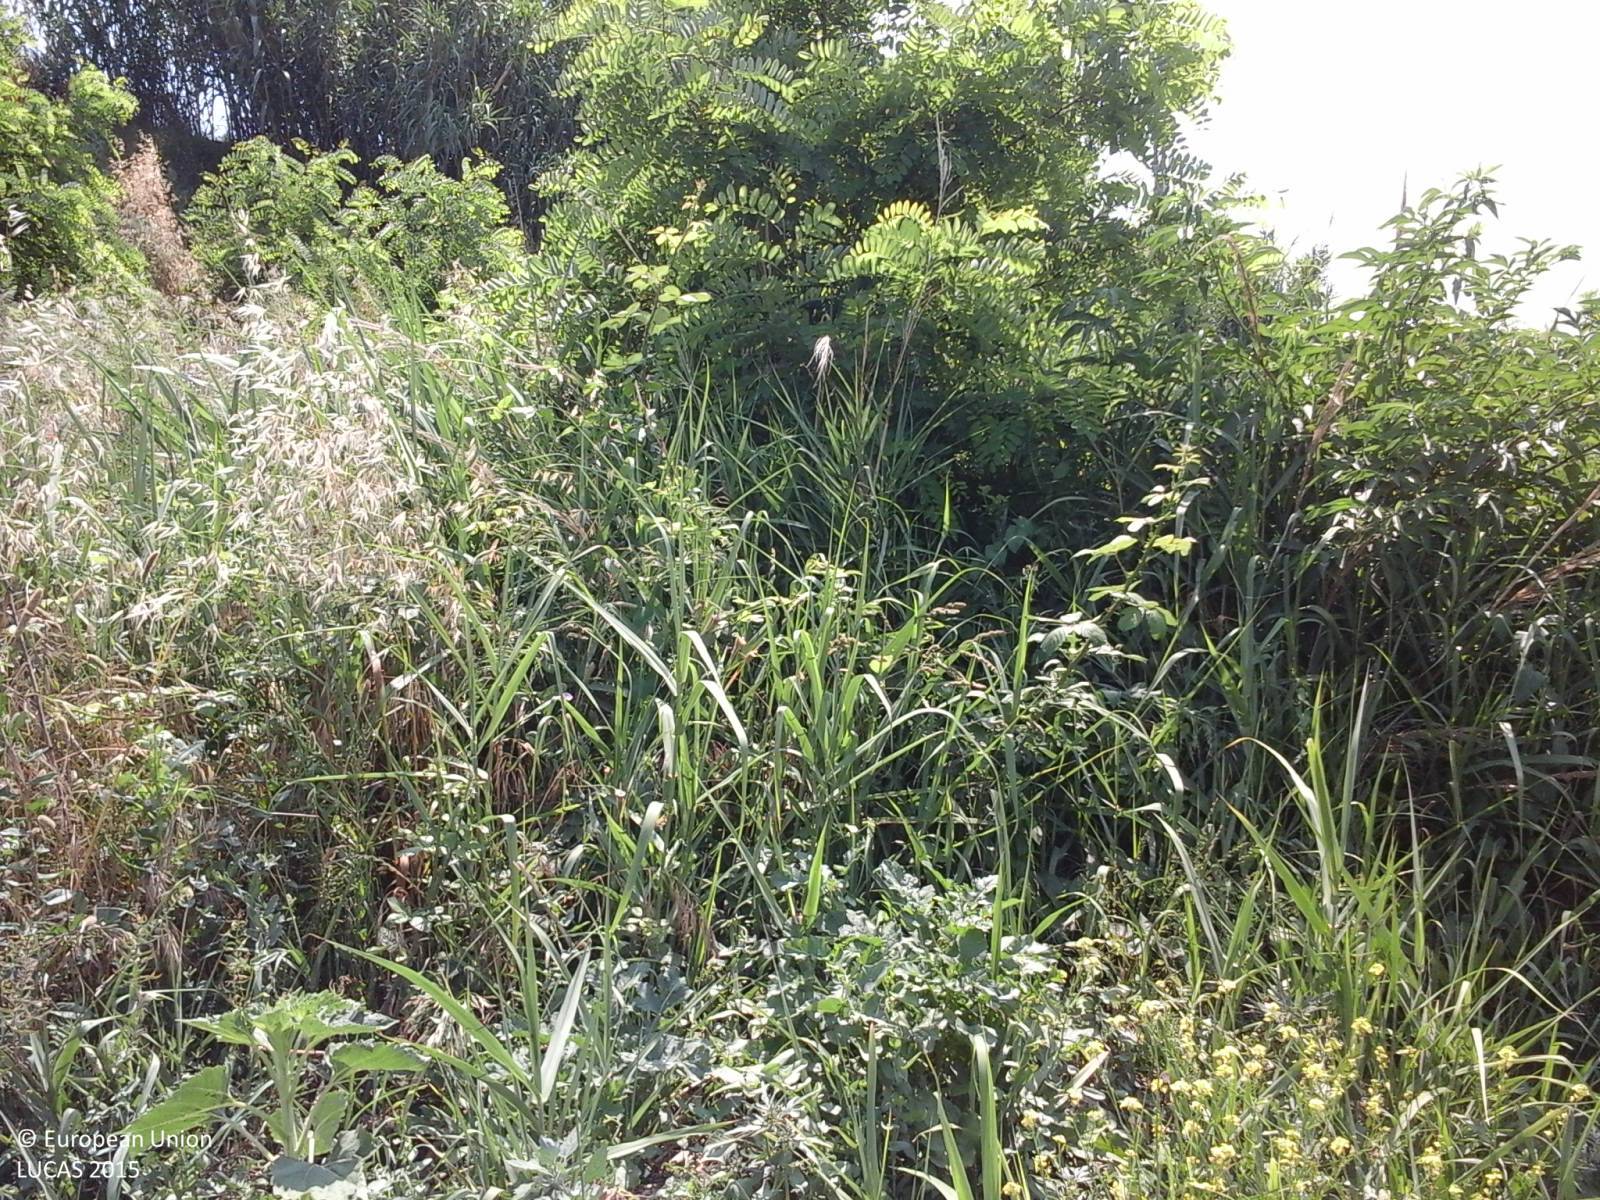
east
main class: Cropland
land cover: Lucerne
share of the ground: 50 - 75 %
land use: Agriculture (excluding fallow land and kitchen gardens)
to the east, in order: Lucerne
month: June
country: IT
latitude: 42.3526
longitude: 11.5848
